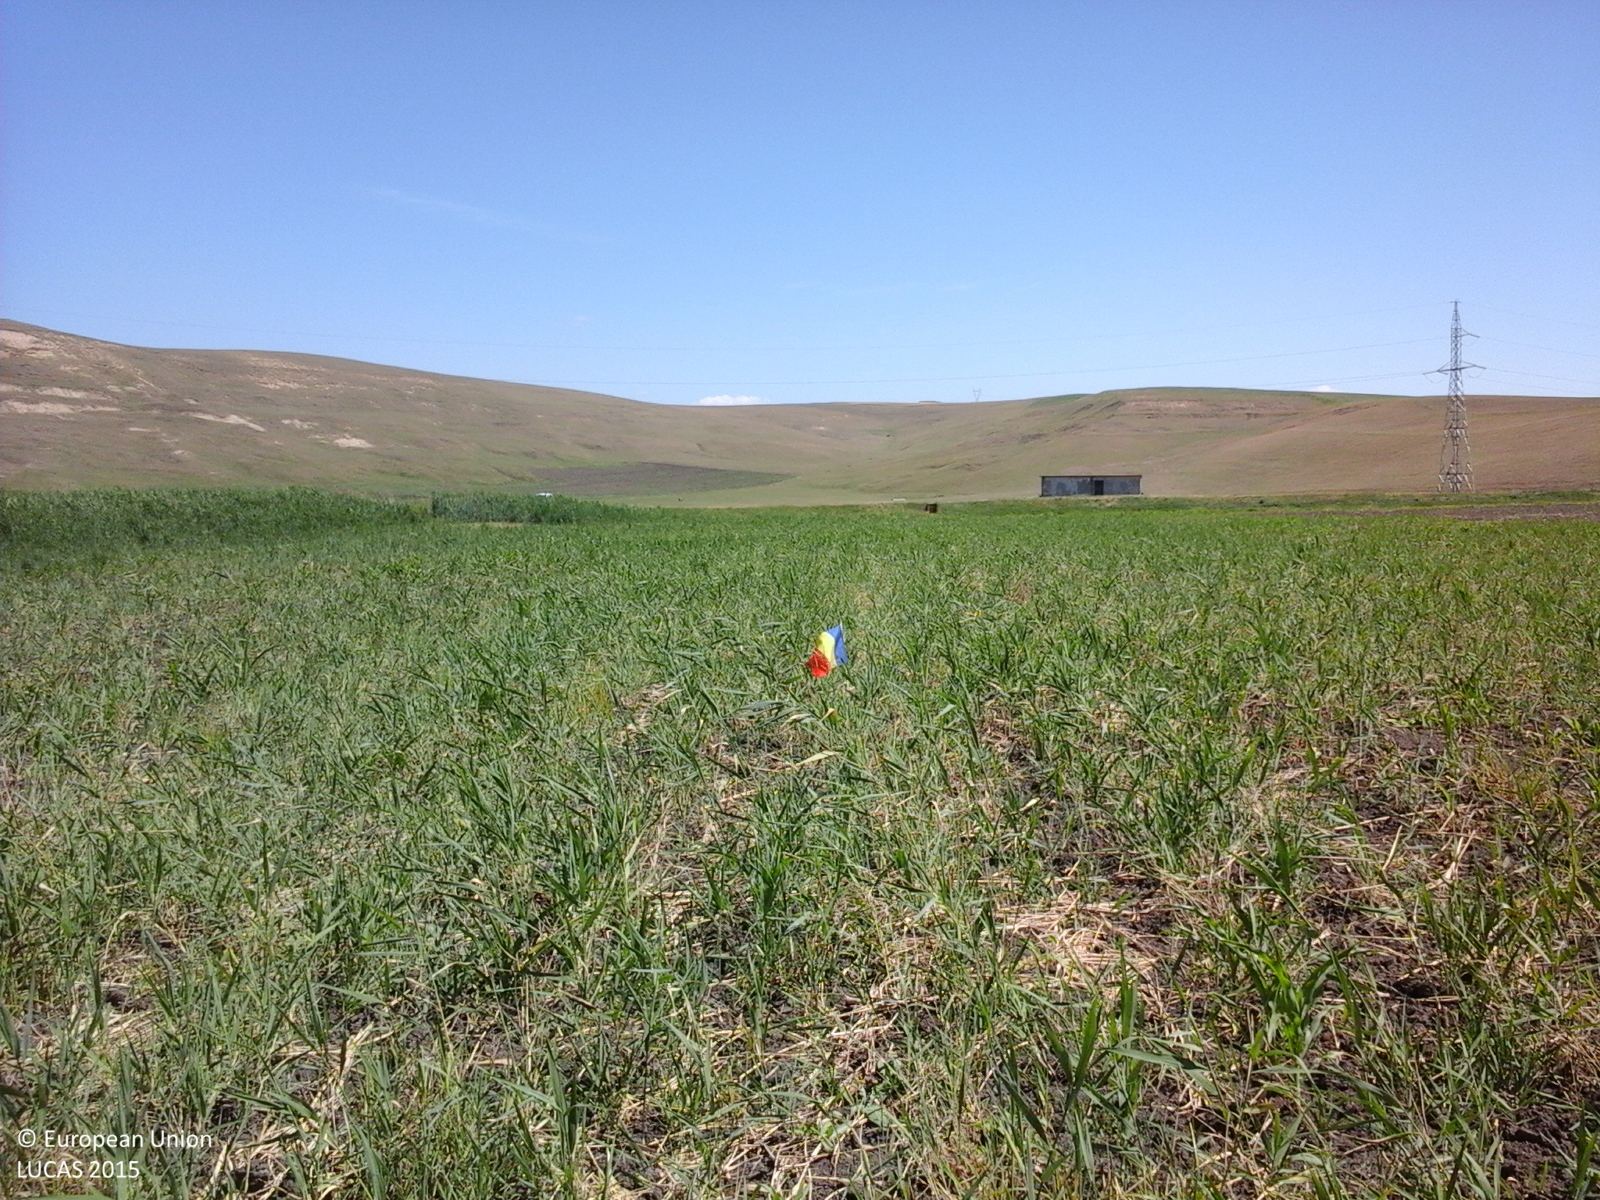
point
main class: Grassland
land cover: Spontaneously vegetated surfaces
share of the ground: > 75 %
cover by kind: herbaceous plants 100 %
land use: Agriculture (excluding fallow land and kitchen gardens)
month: June
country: RO
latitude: 47.2533
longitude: 27.0289
